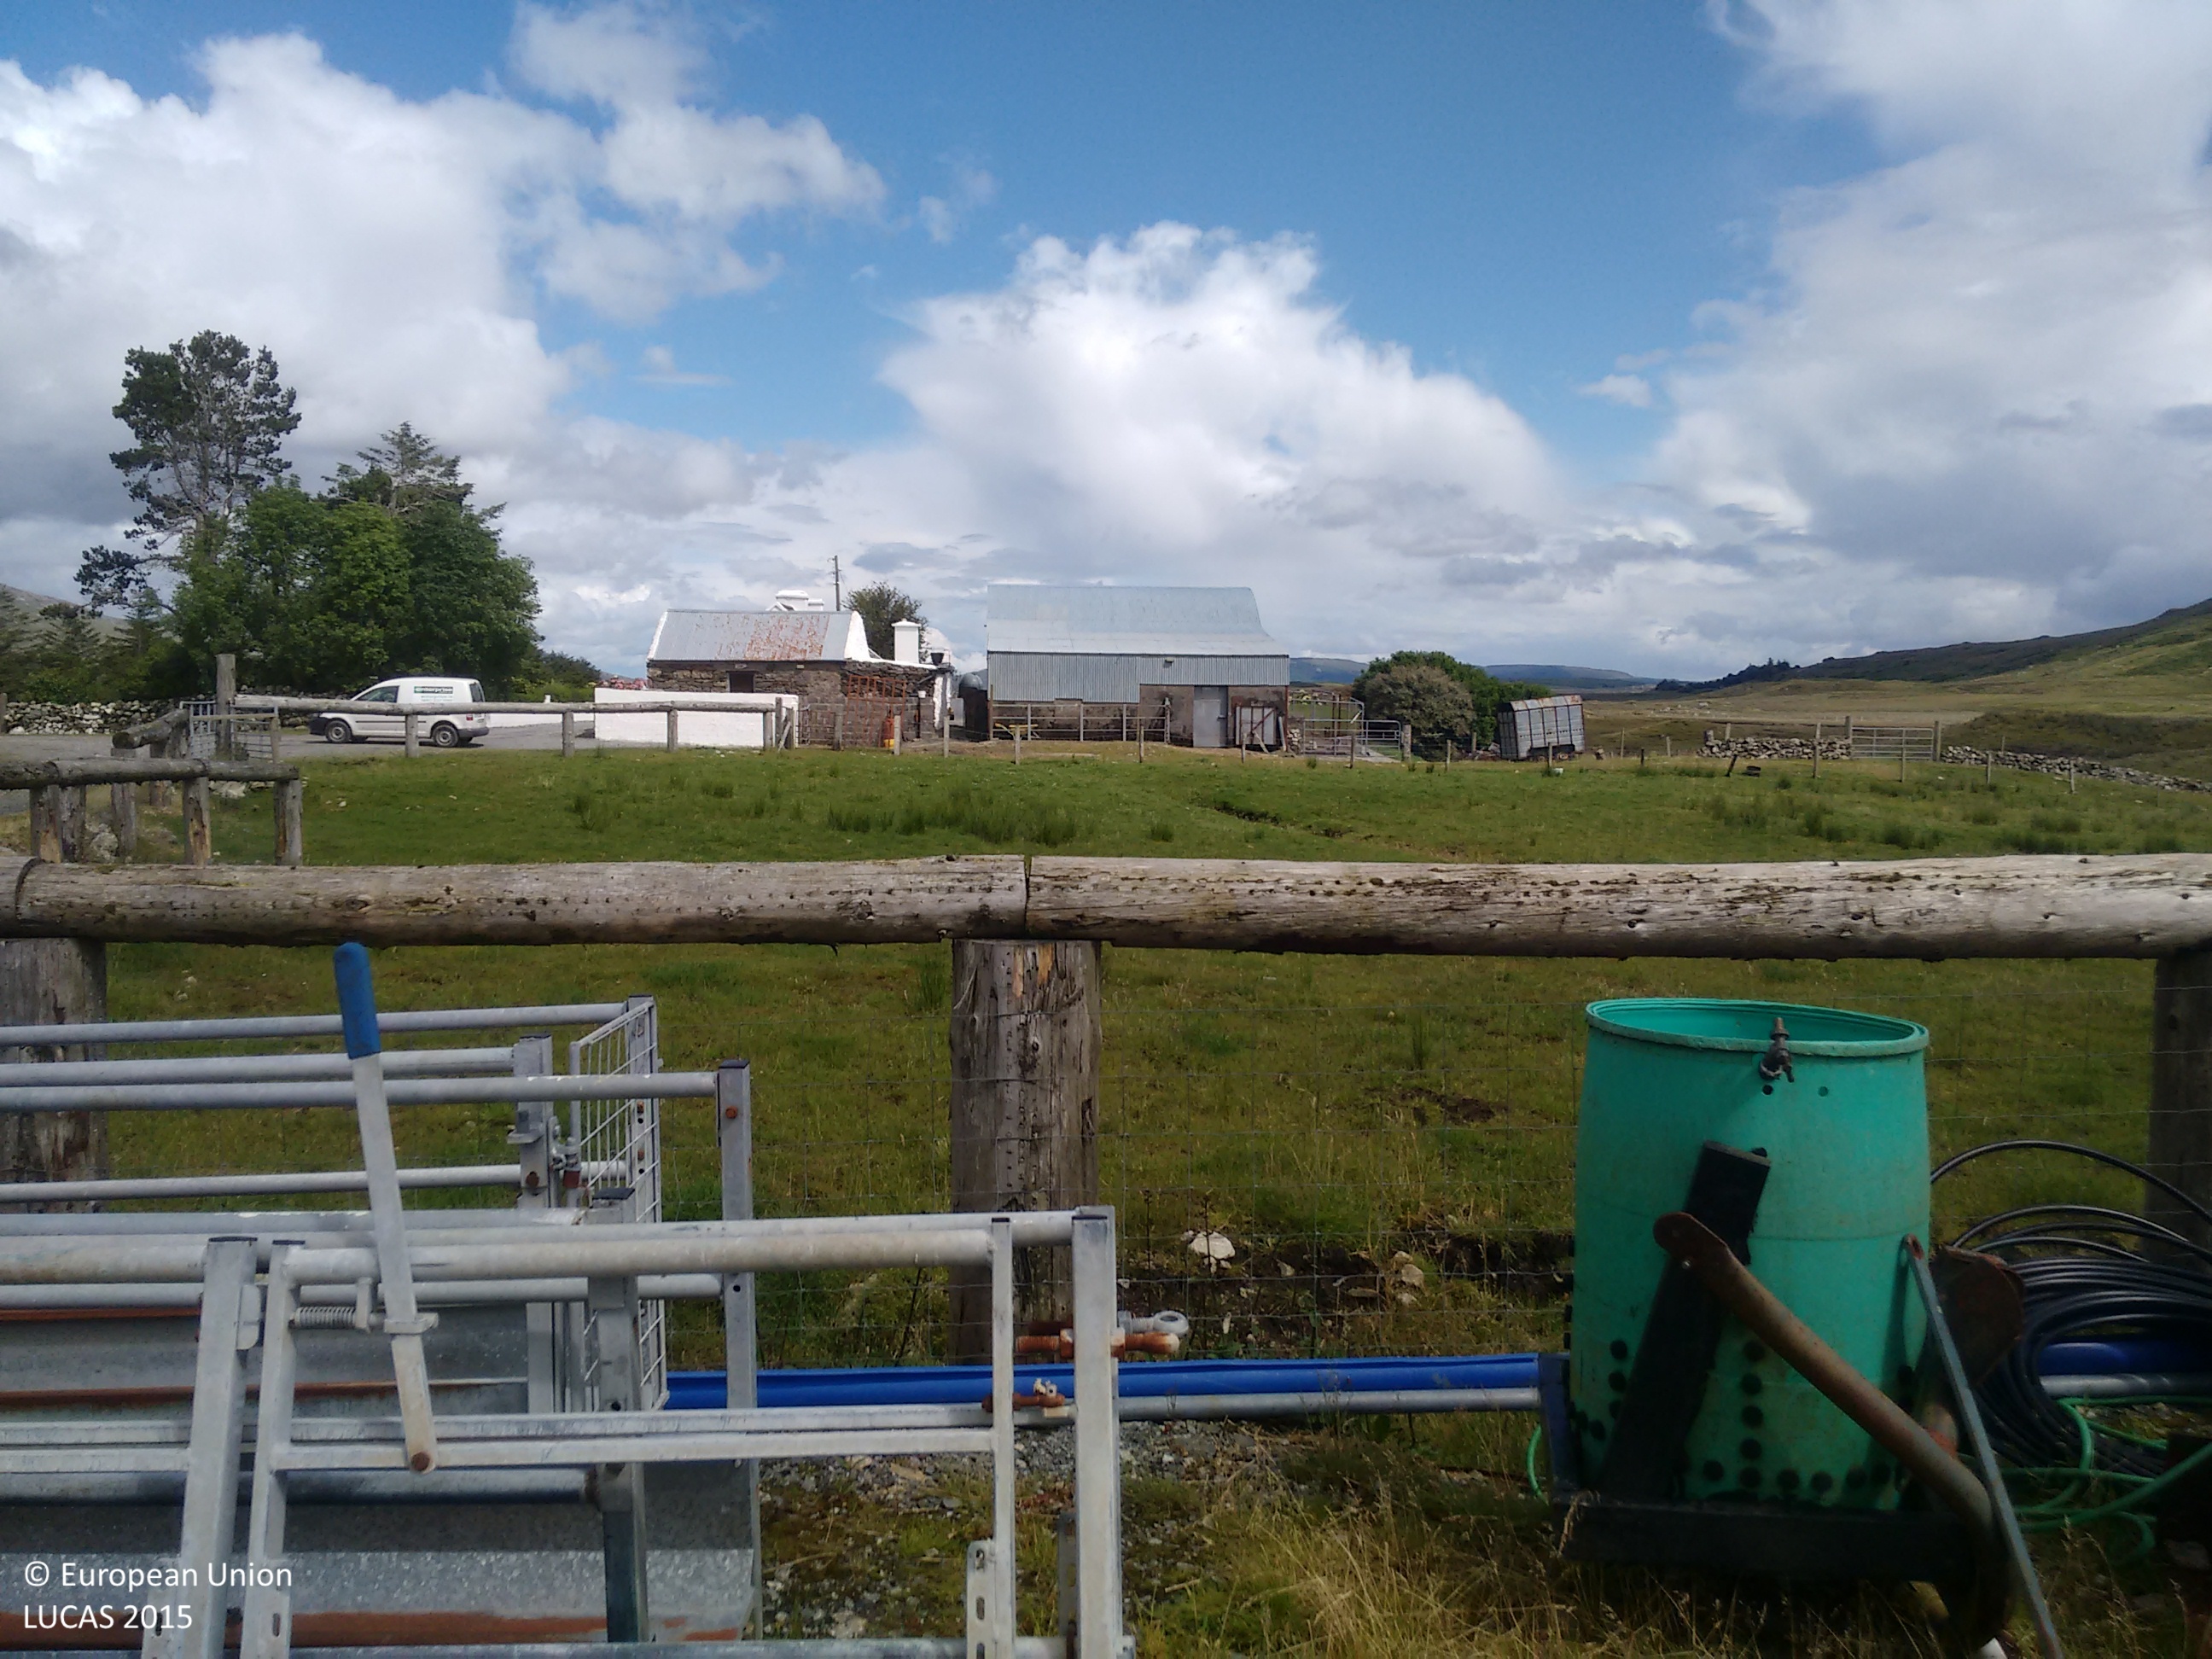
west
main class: Grassland
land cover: Grassland without tree/shrub cover
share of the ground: > 75 %
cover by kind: herbaceous plants 80 %, consolidated bare surface 20 %
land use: Agriculture (excluding fallow land and kitchen gardens)
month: July
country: IE
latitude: 53.4428
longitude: -9.6134
